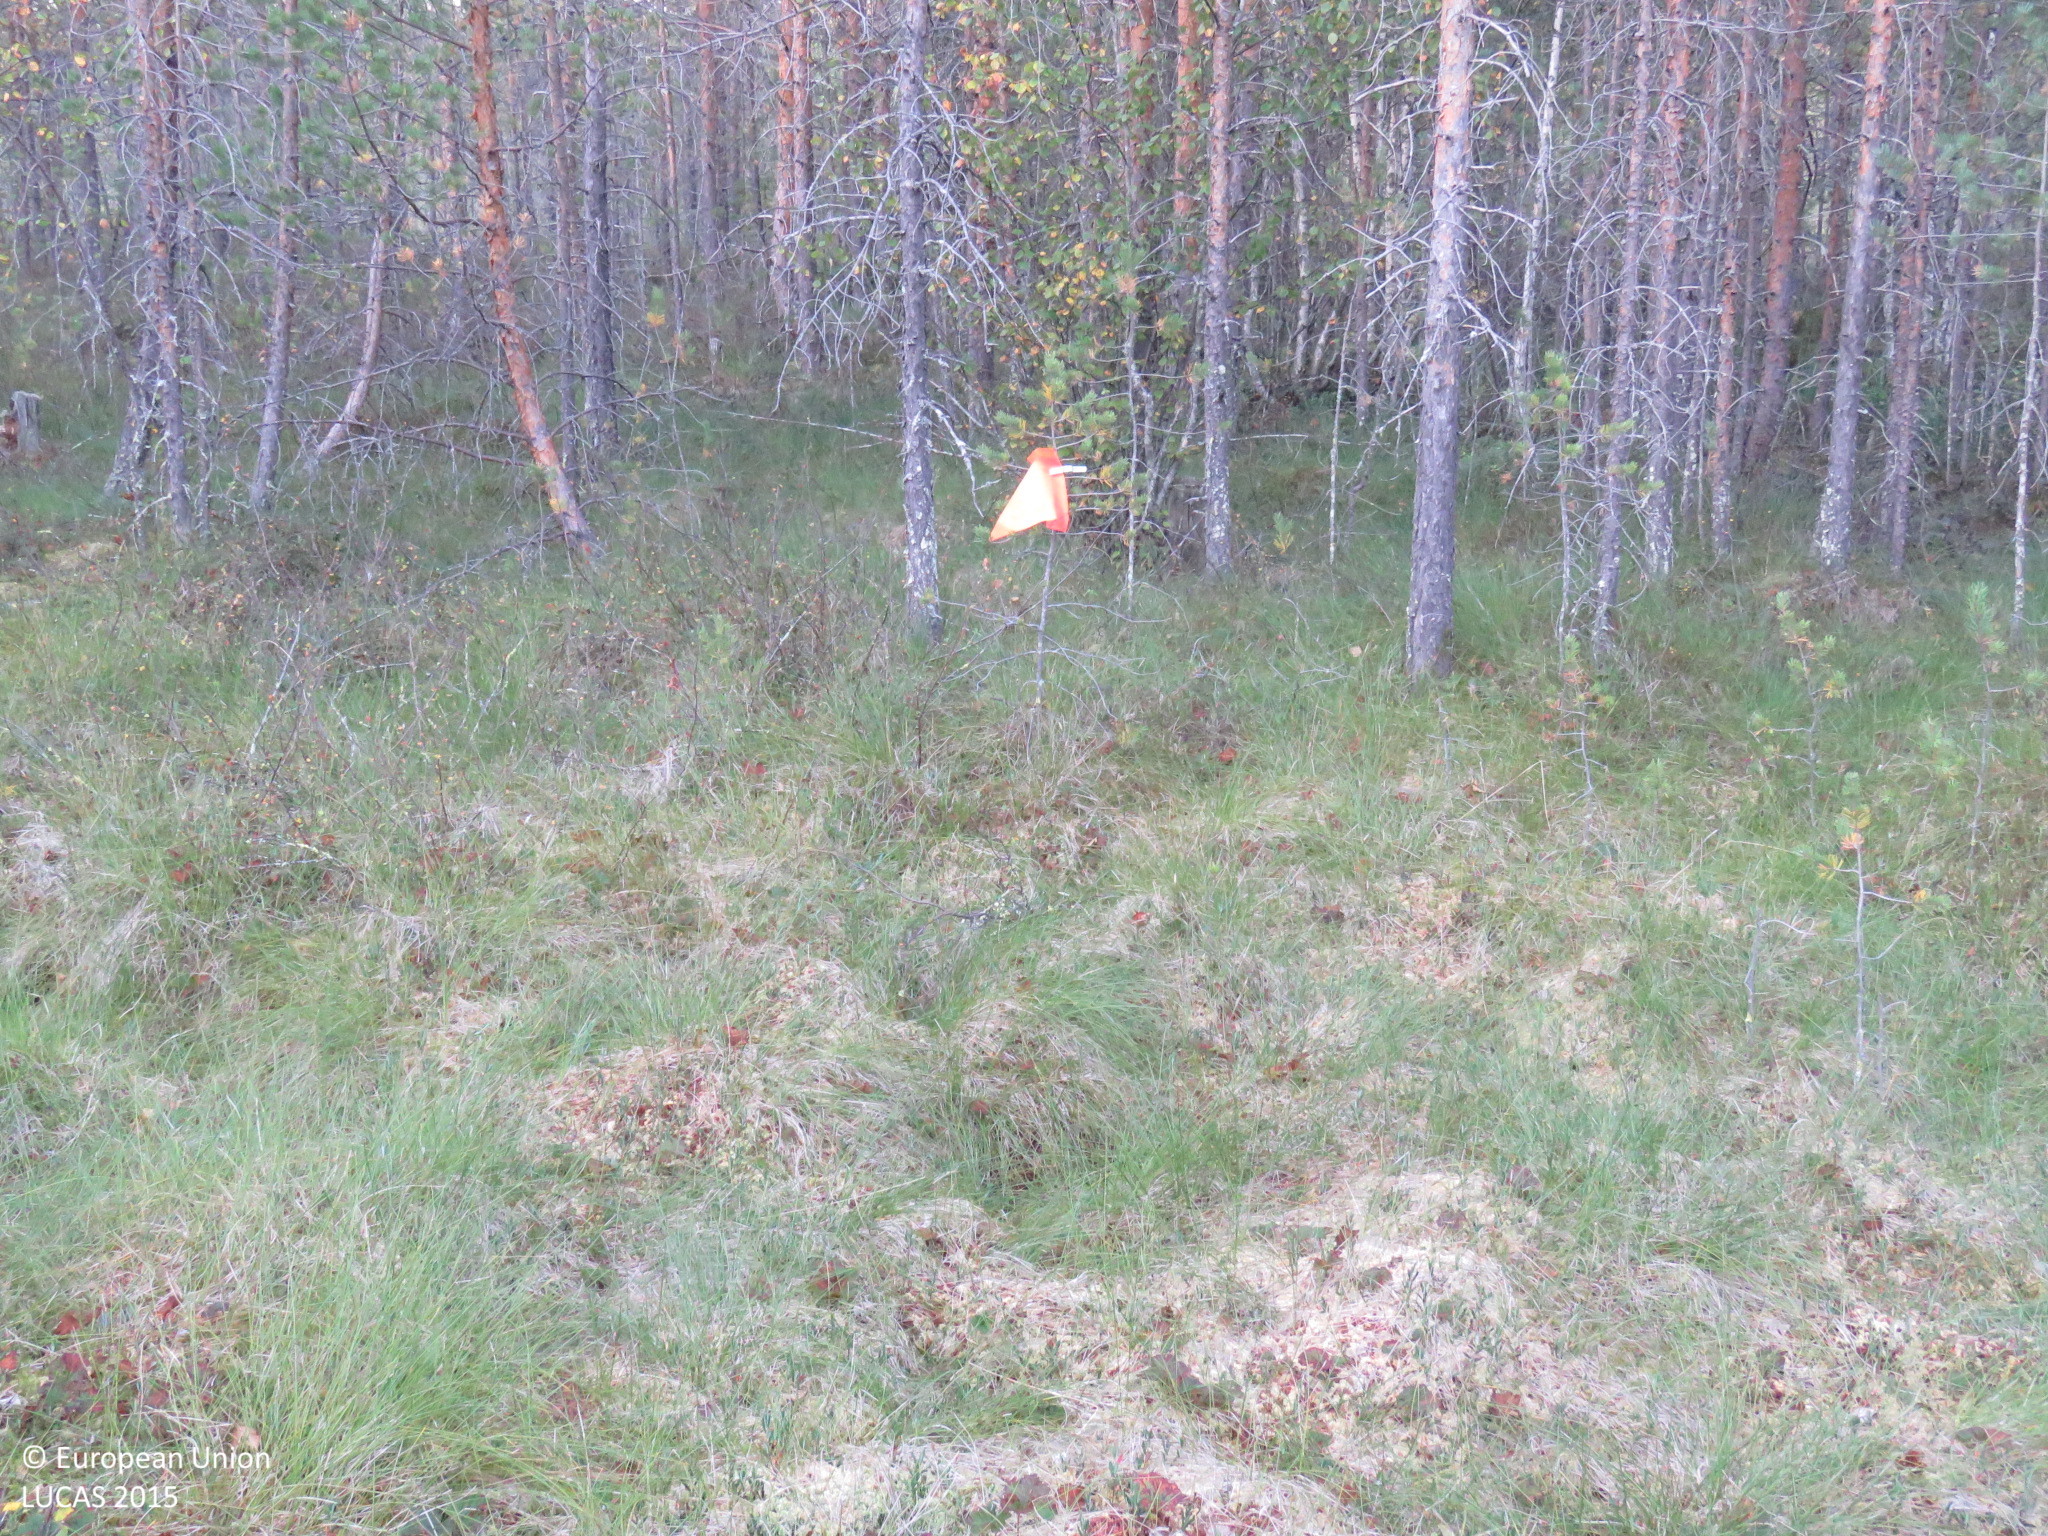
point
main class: Woodland
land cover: Pine dominated coniferous woodland
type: mire and swamp forests
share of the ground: 50 - 75 %
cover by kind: coniferous forest trees 50 %, herbaceous plants 20 %, broadleaved forest trees 15 %, shrubs 10 %, lichens and mosses 5 %
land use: Forestry
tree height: > 5 m
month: August
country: FI
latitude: 64.9970
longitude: 25.8901
